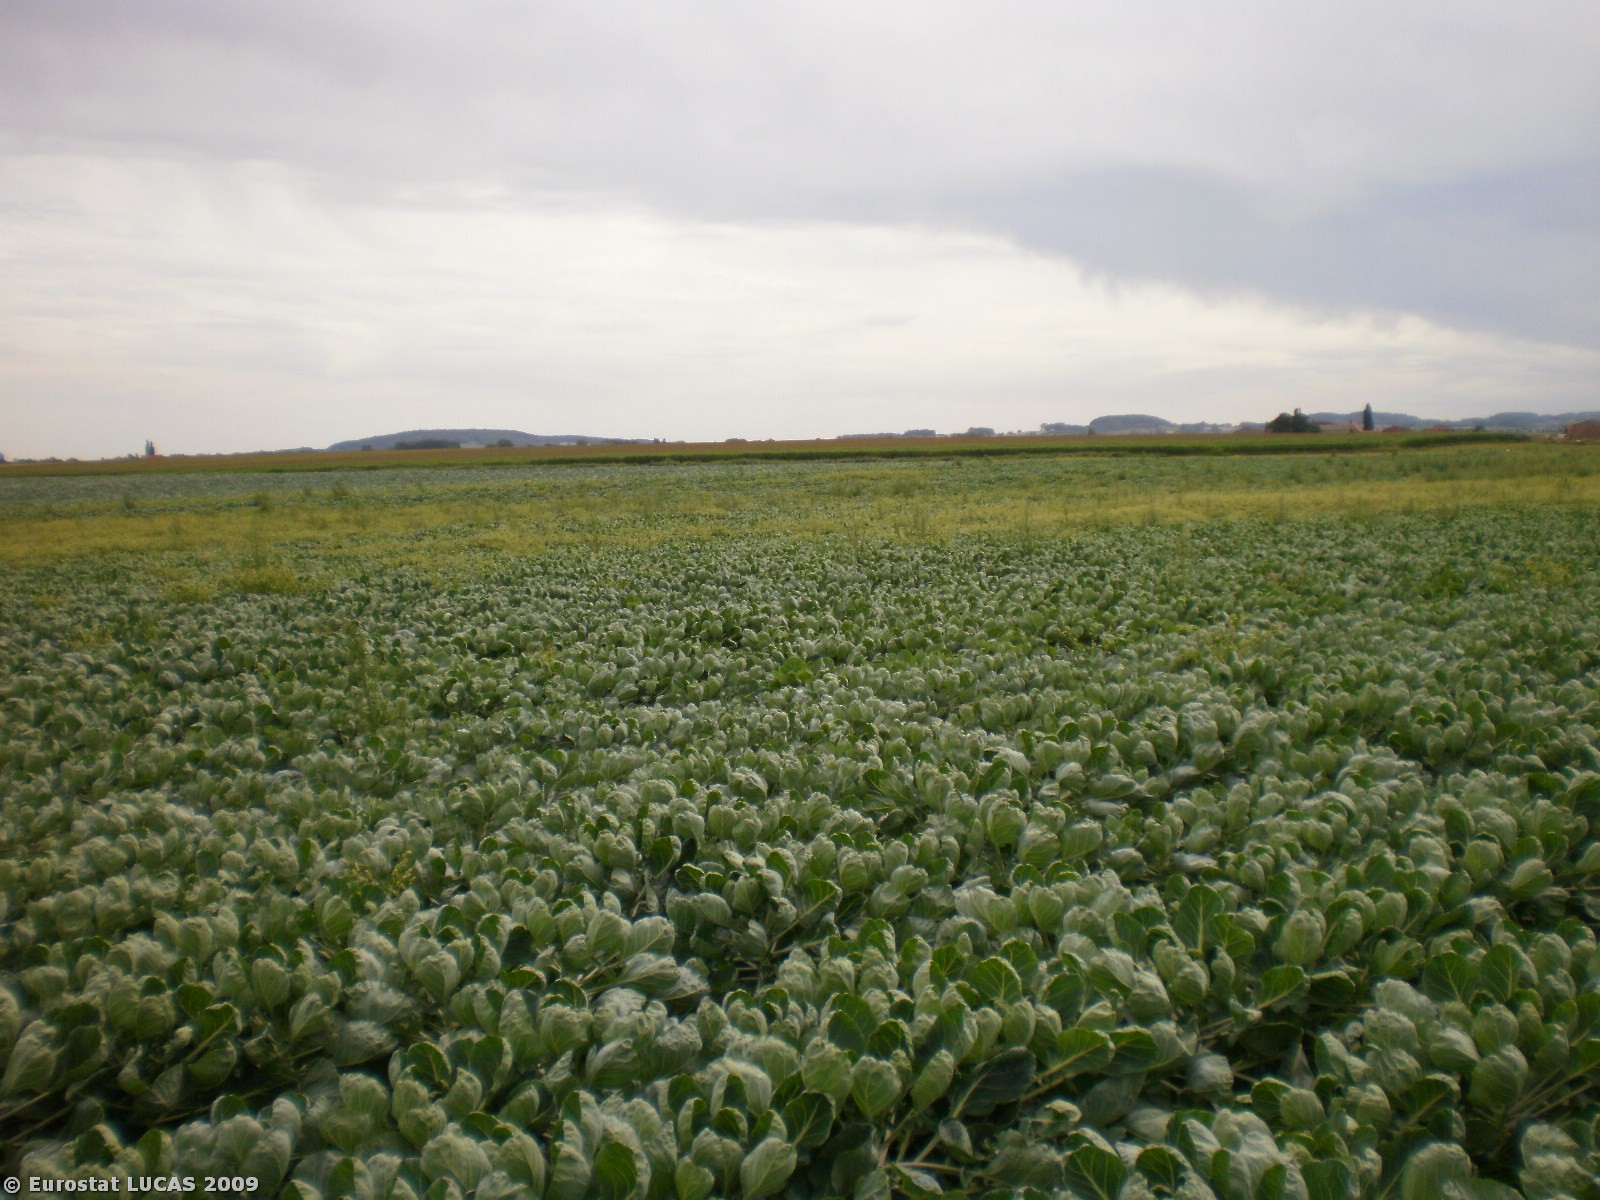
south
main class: Cropland
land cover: Other fresh vegetables
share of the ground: > 75 %
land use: Agriculture (excluding fallow land and kitchen gardens)
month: July
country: BE
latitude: 50.8422
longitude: 2.8172
